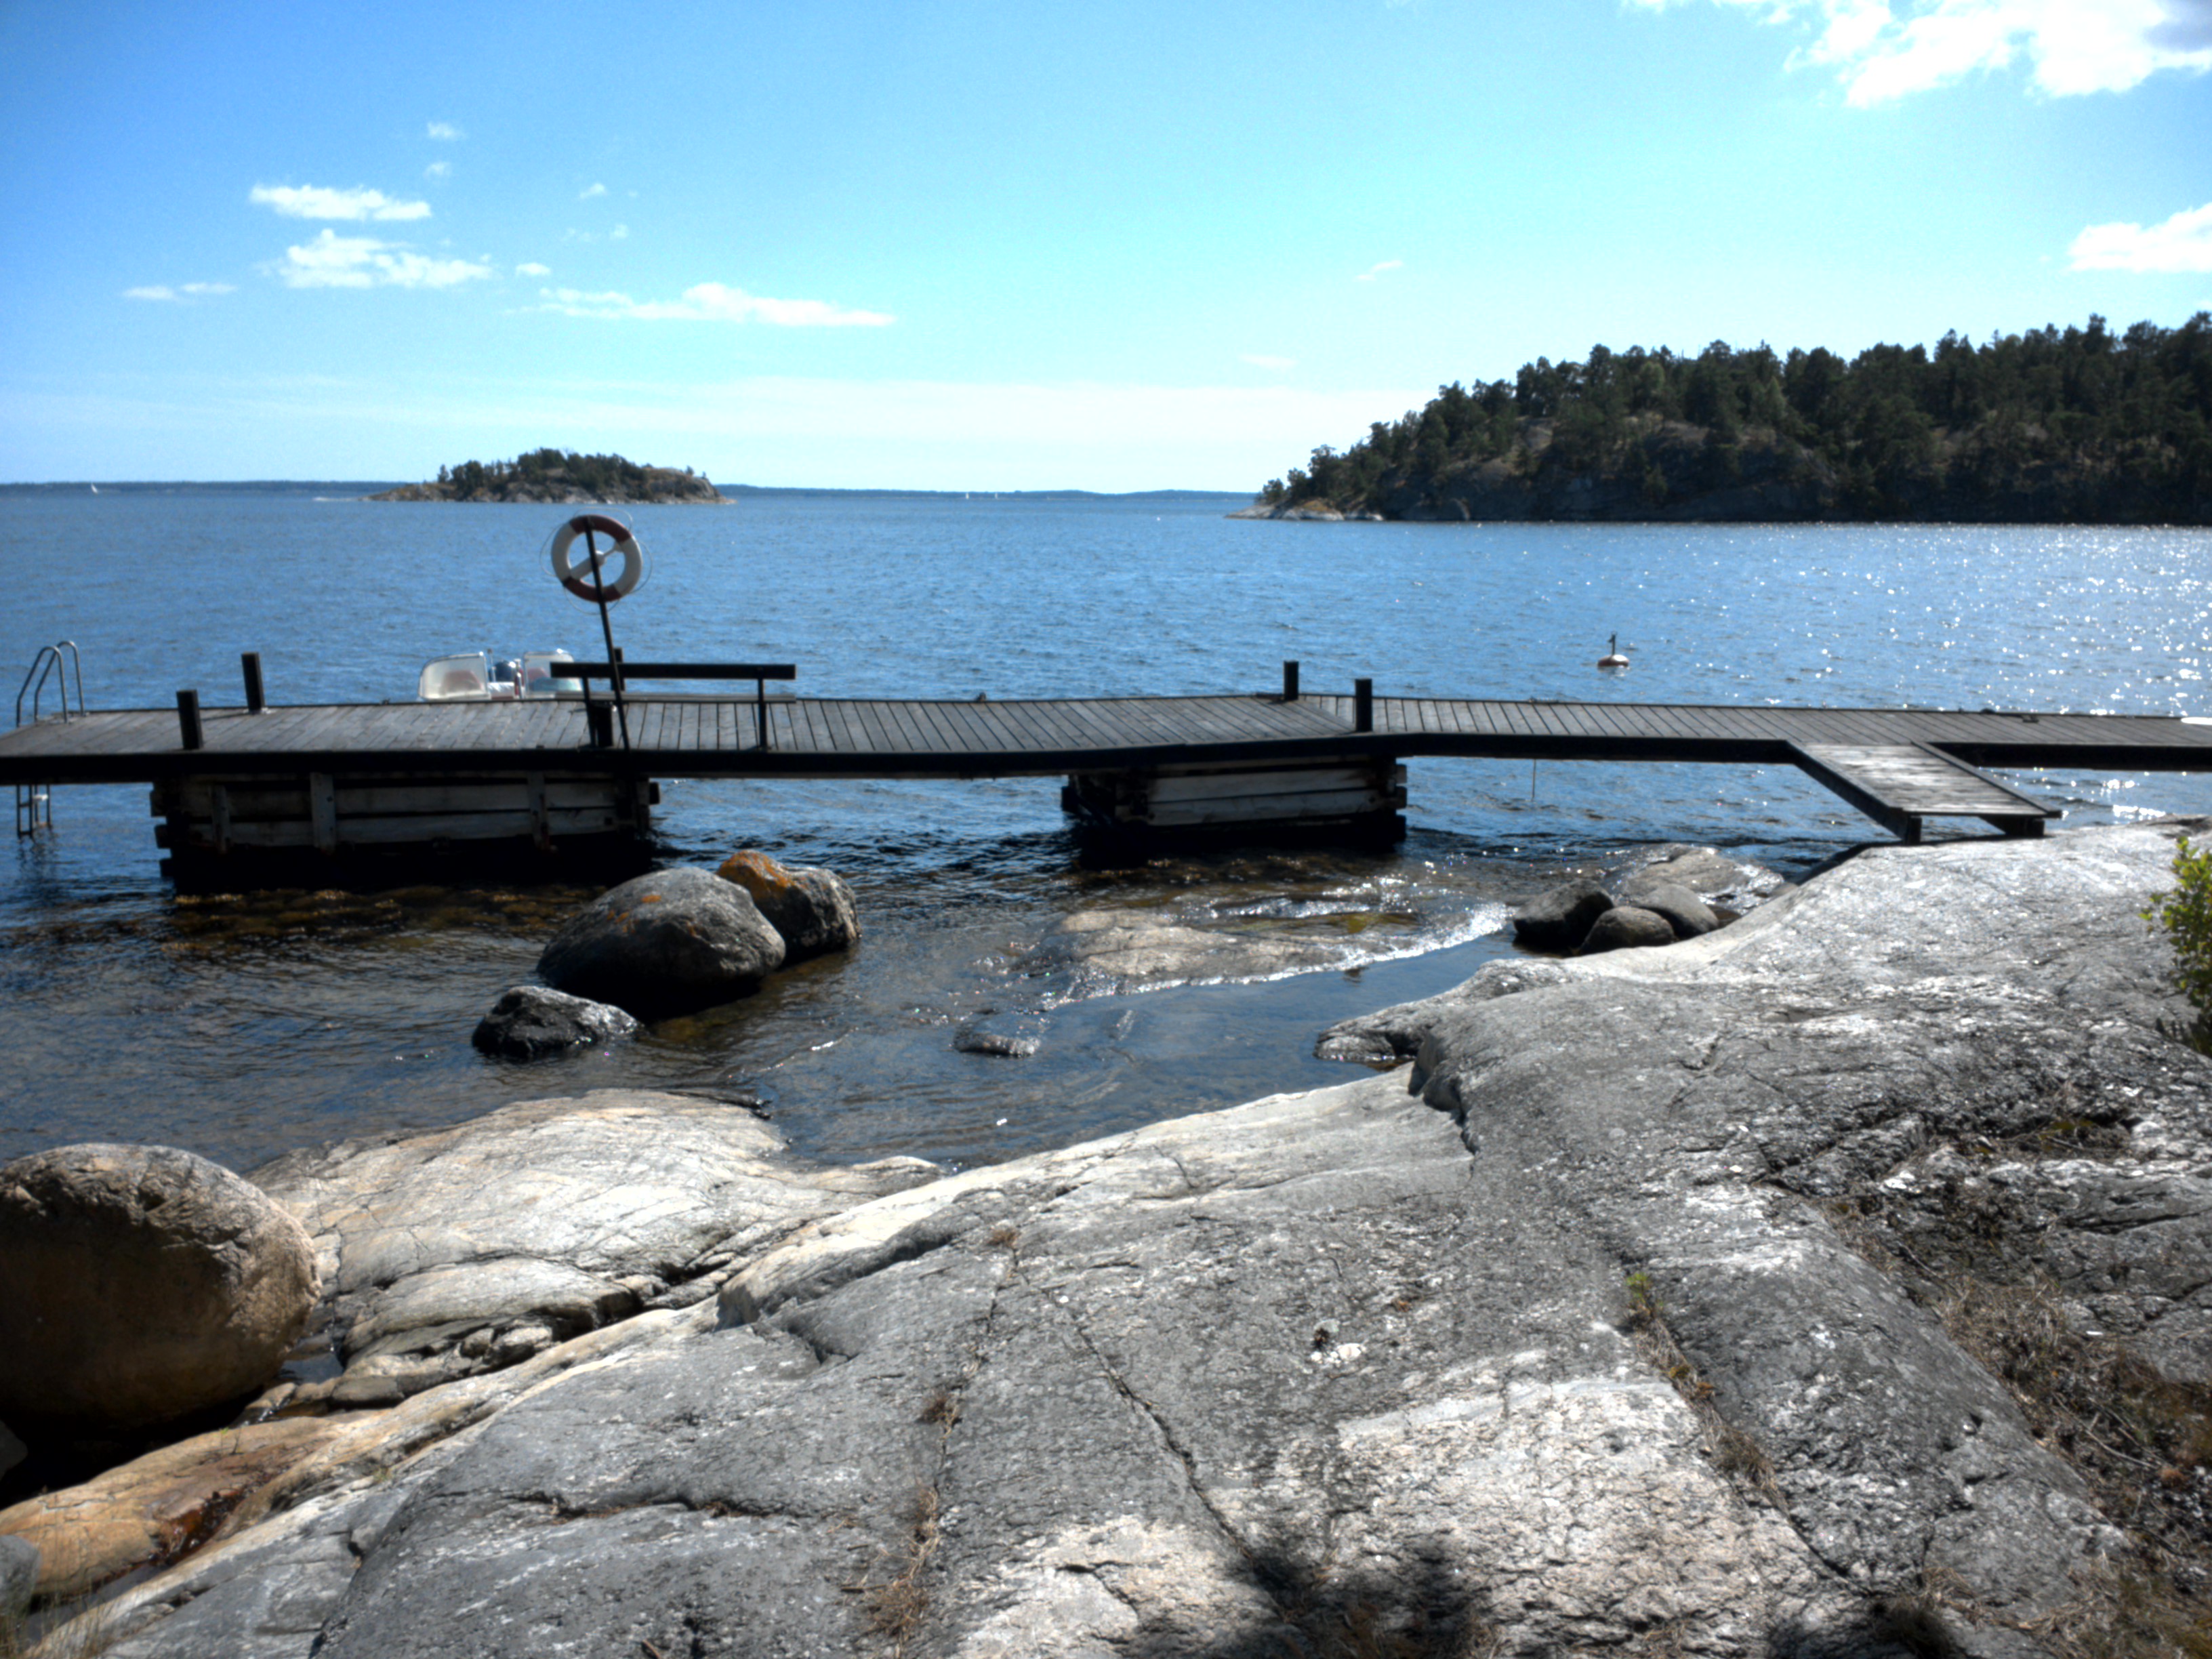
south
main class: Woodland
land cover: Pine dominated coniferous woodland
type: boreal forest
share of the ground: 25 - 50 %
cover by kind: coniferous forest trees 40 %, shrubs 40 %, lichens and mosses 20 %
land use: Amenities, museums, leisure
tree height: > 5 m
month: July
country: SE
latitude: 59.0182
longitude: 18.2040
